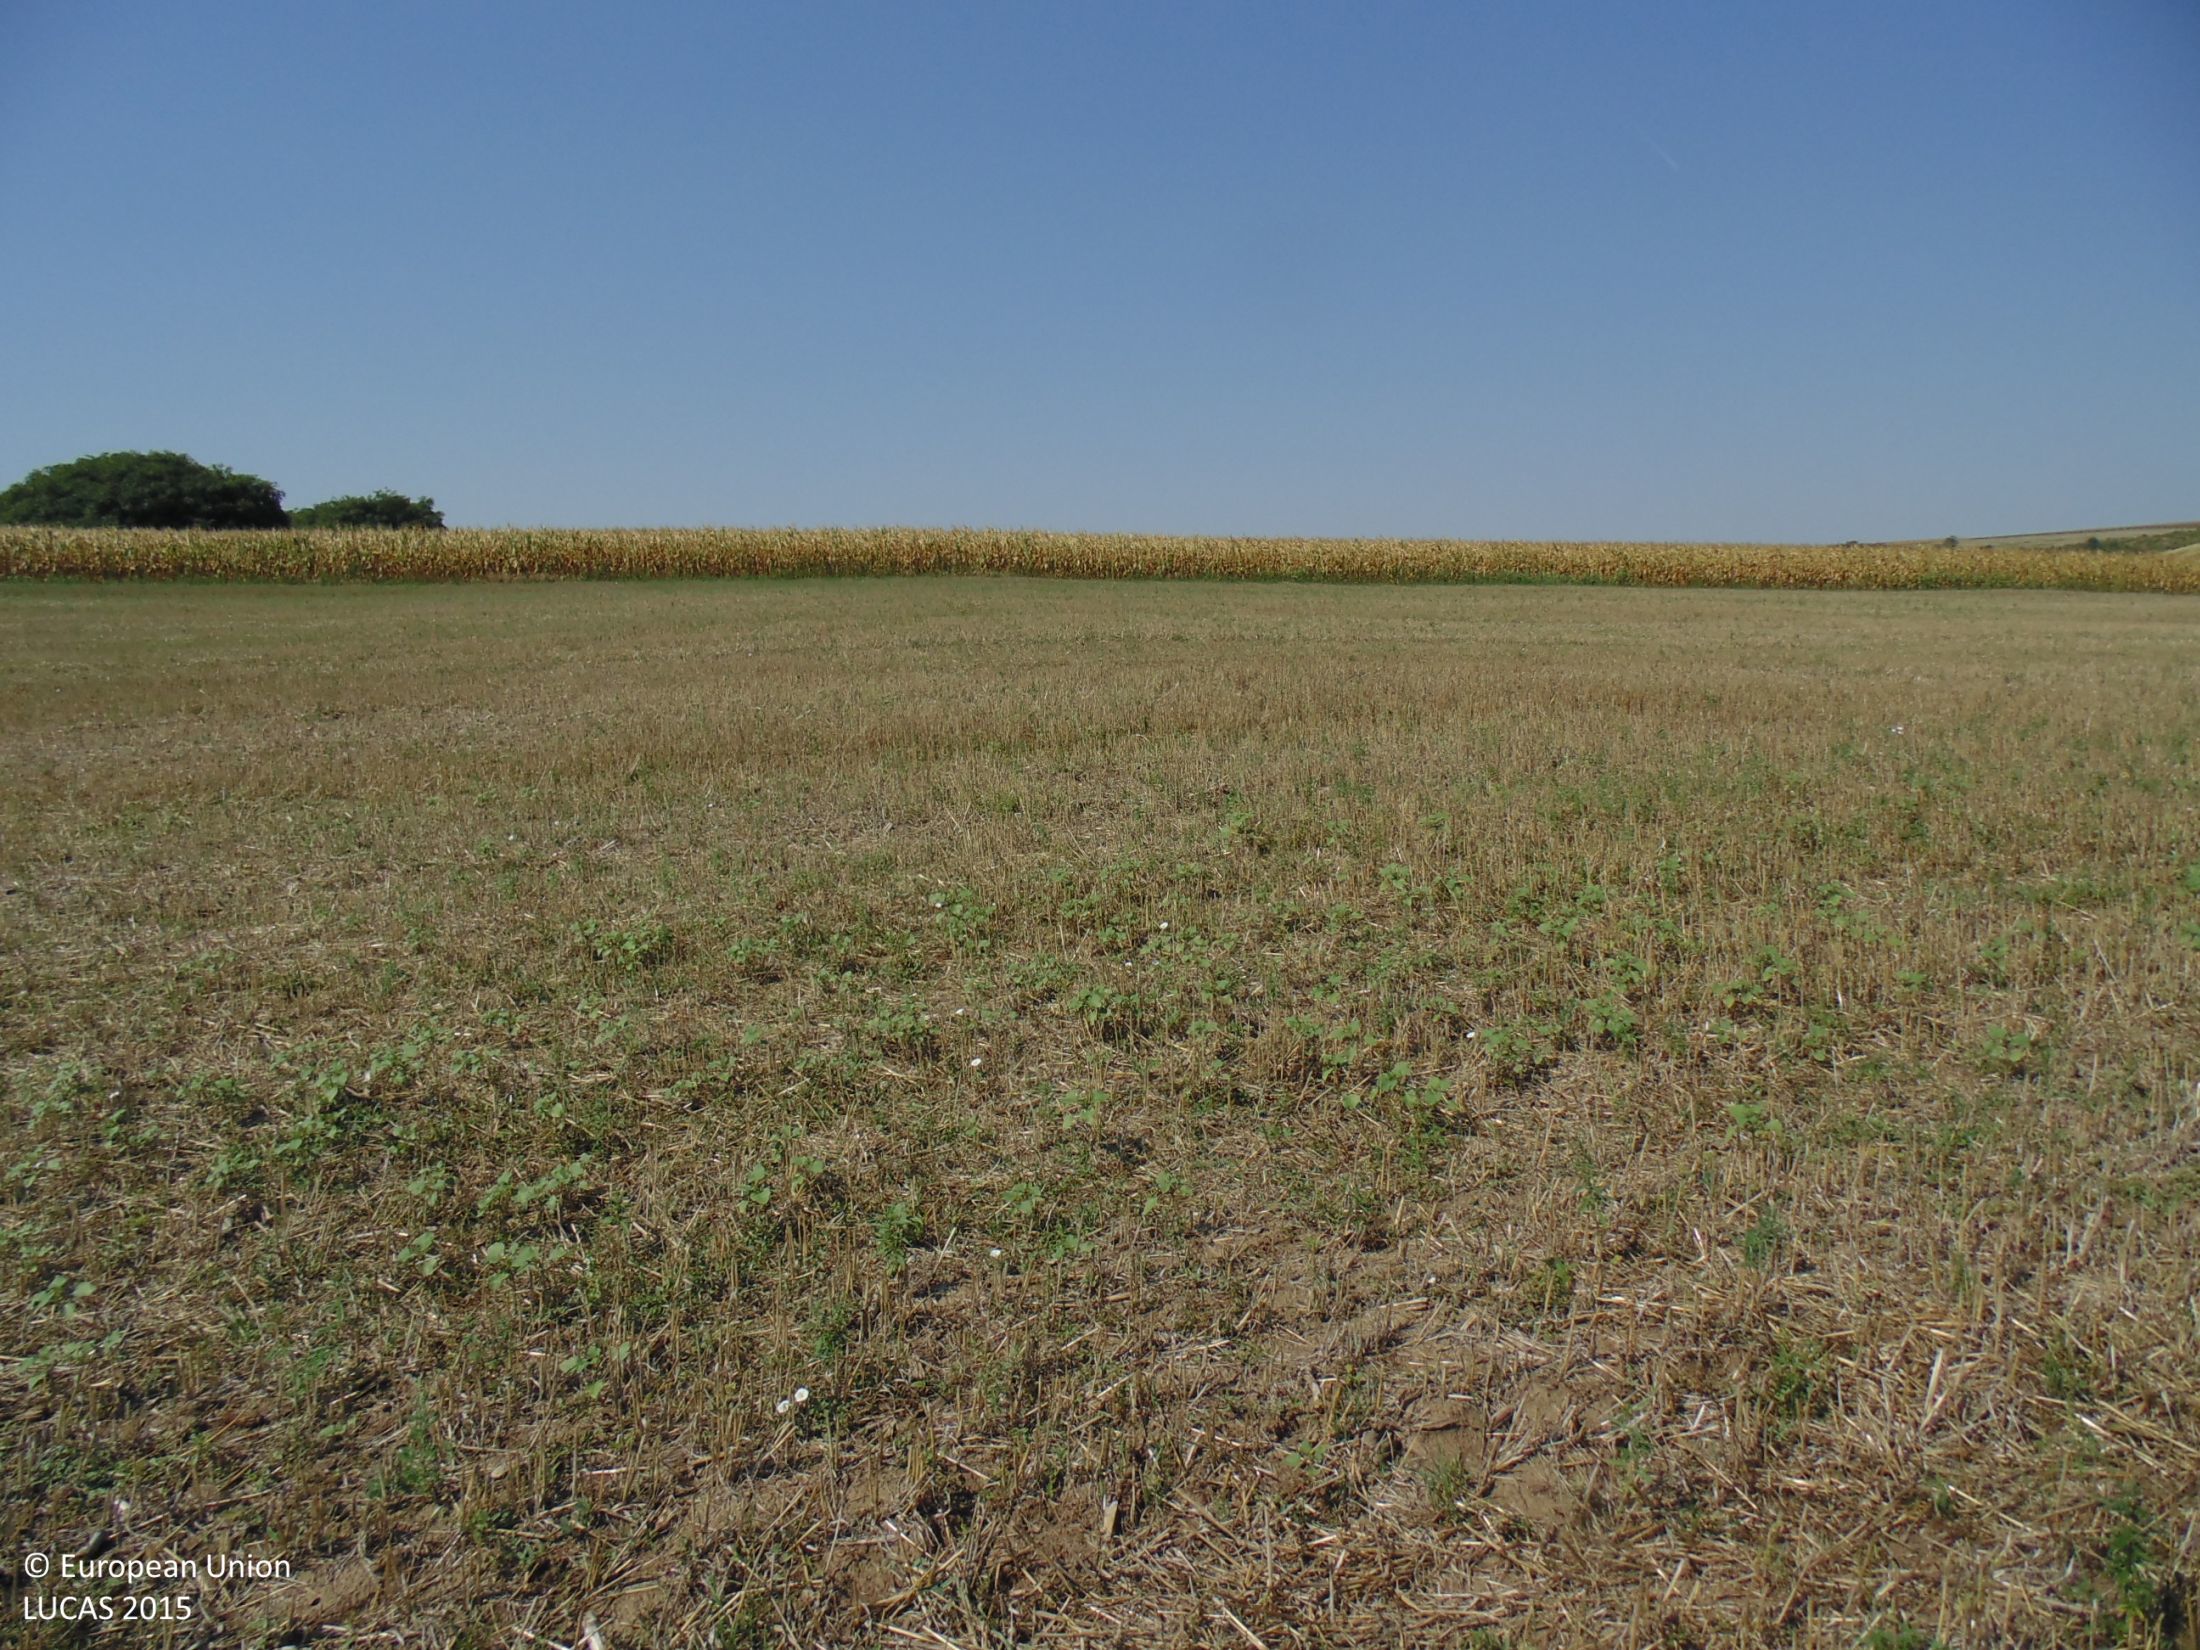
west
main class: Cropland
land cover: Common wheat
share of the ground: 10 - 25 %
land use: Agriculture (excluding fallow land and kitchen gardens)
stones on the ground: < 10 %
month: August
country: BG
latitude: 43.7022
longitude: 27.4680
